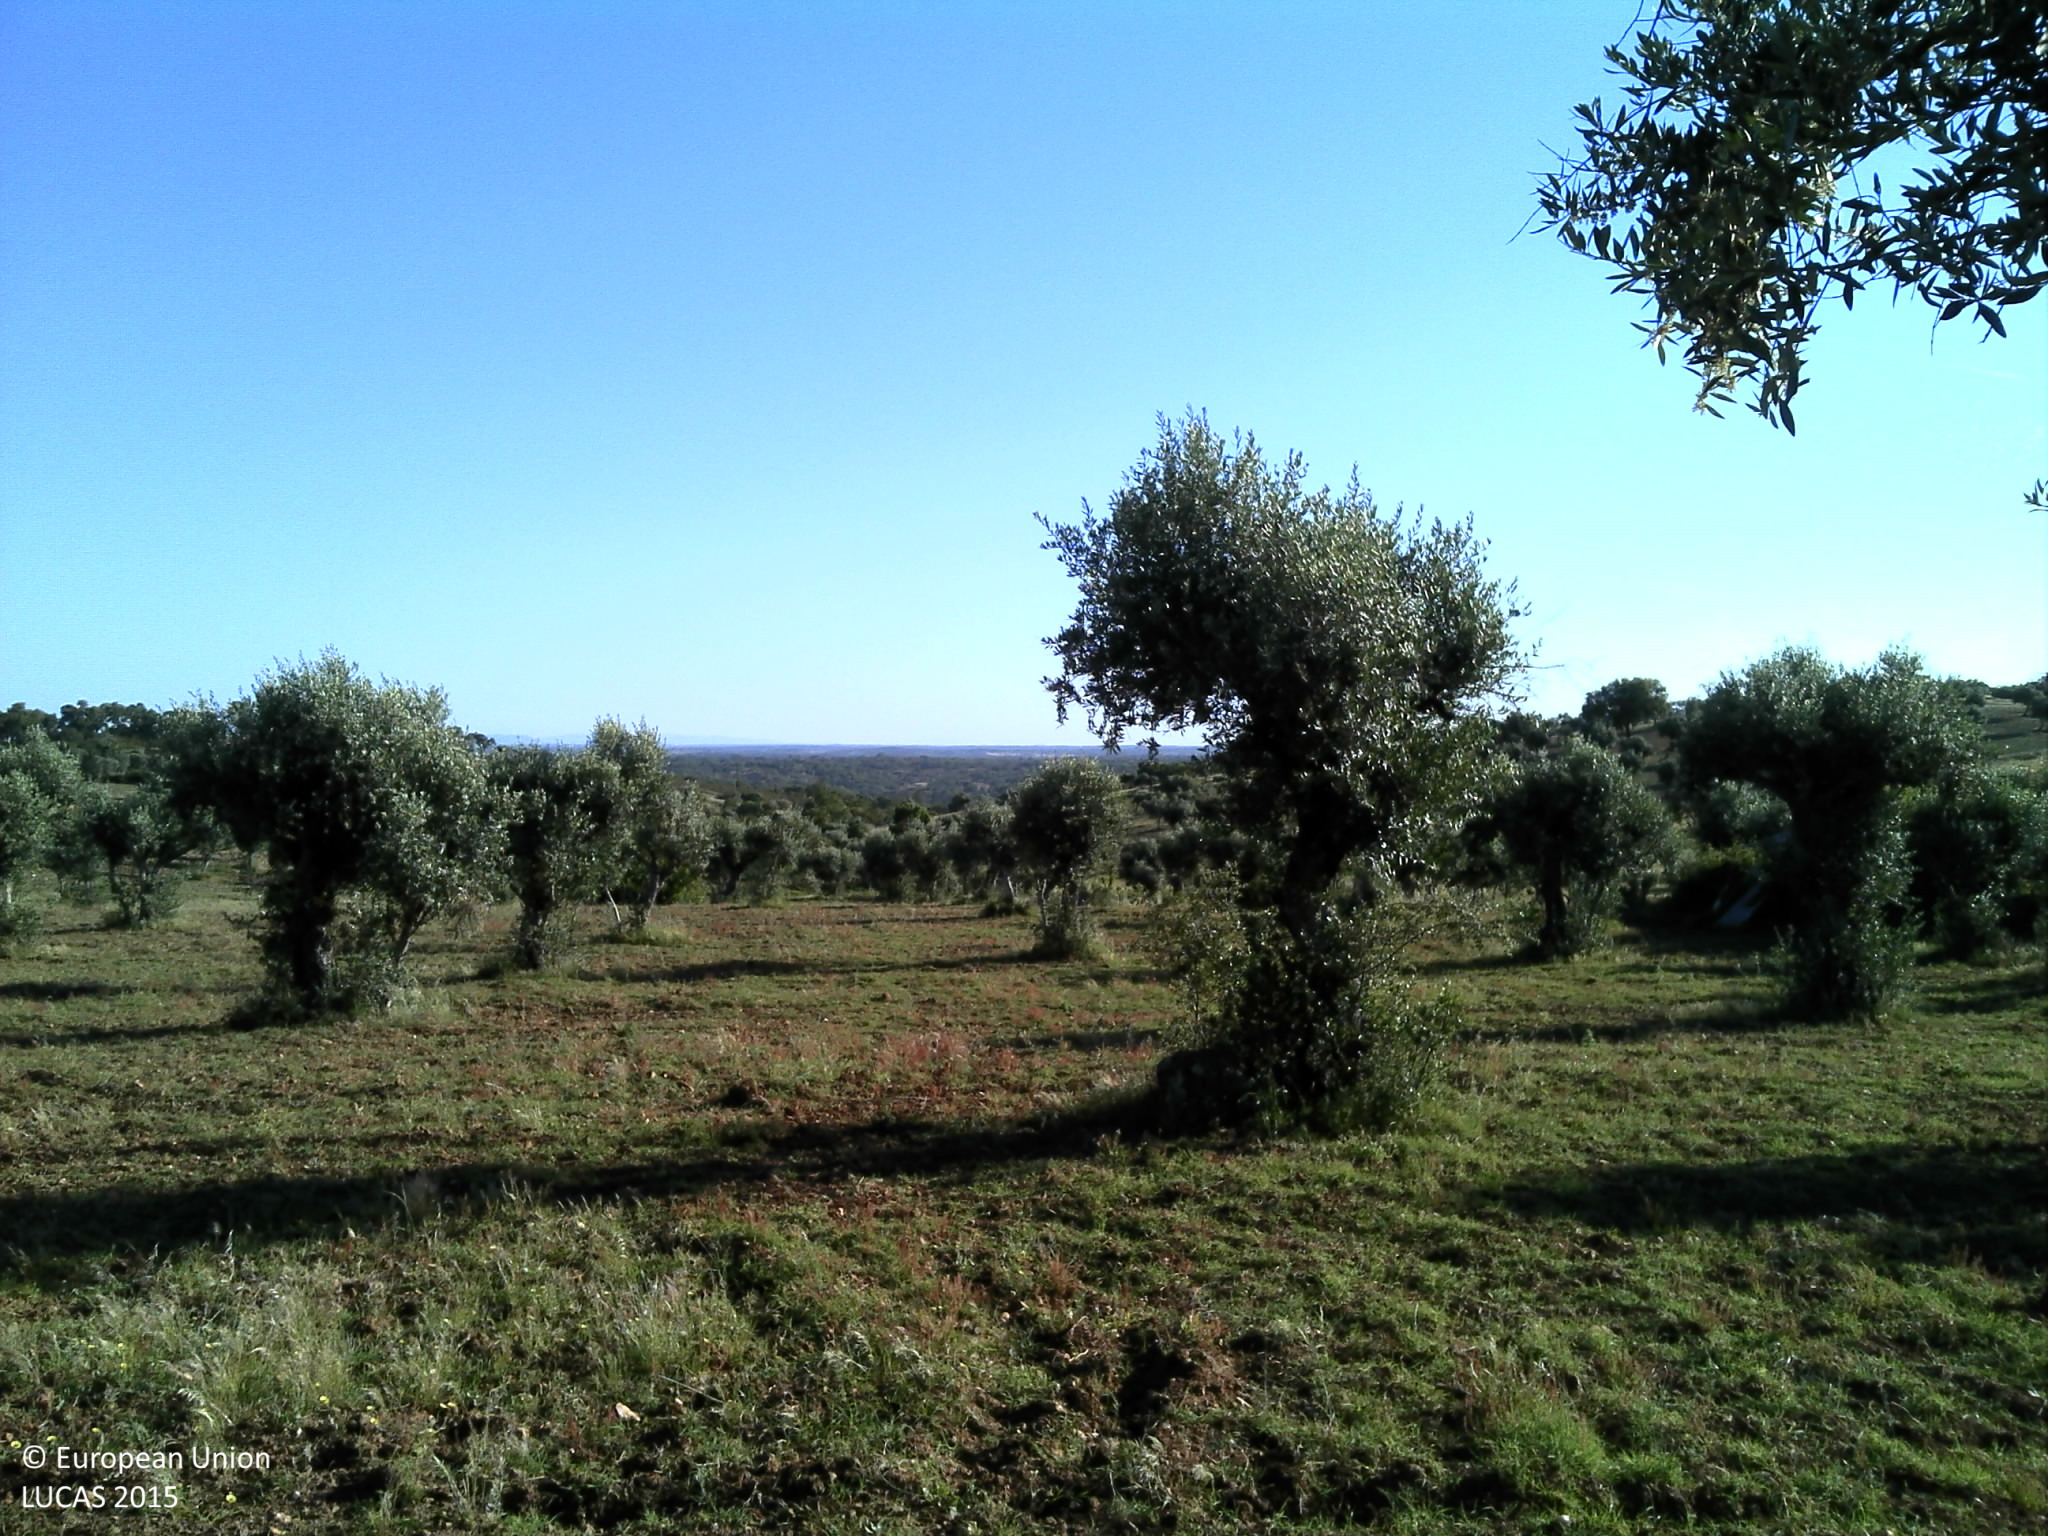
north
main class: Cropland
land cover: Olive groves
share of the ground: 10 - 25 %
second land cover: Grassland without tree/shrub cover
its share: 10 - 25 %
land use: Agriculture (excluding fallow land and kitchen gardens)
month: May
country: PT
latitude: 39.1638
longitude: -7.9797
